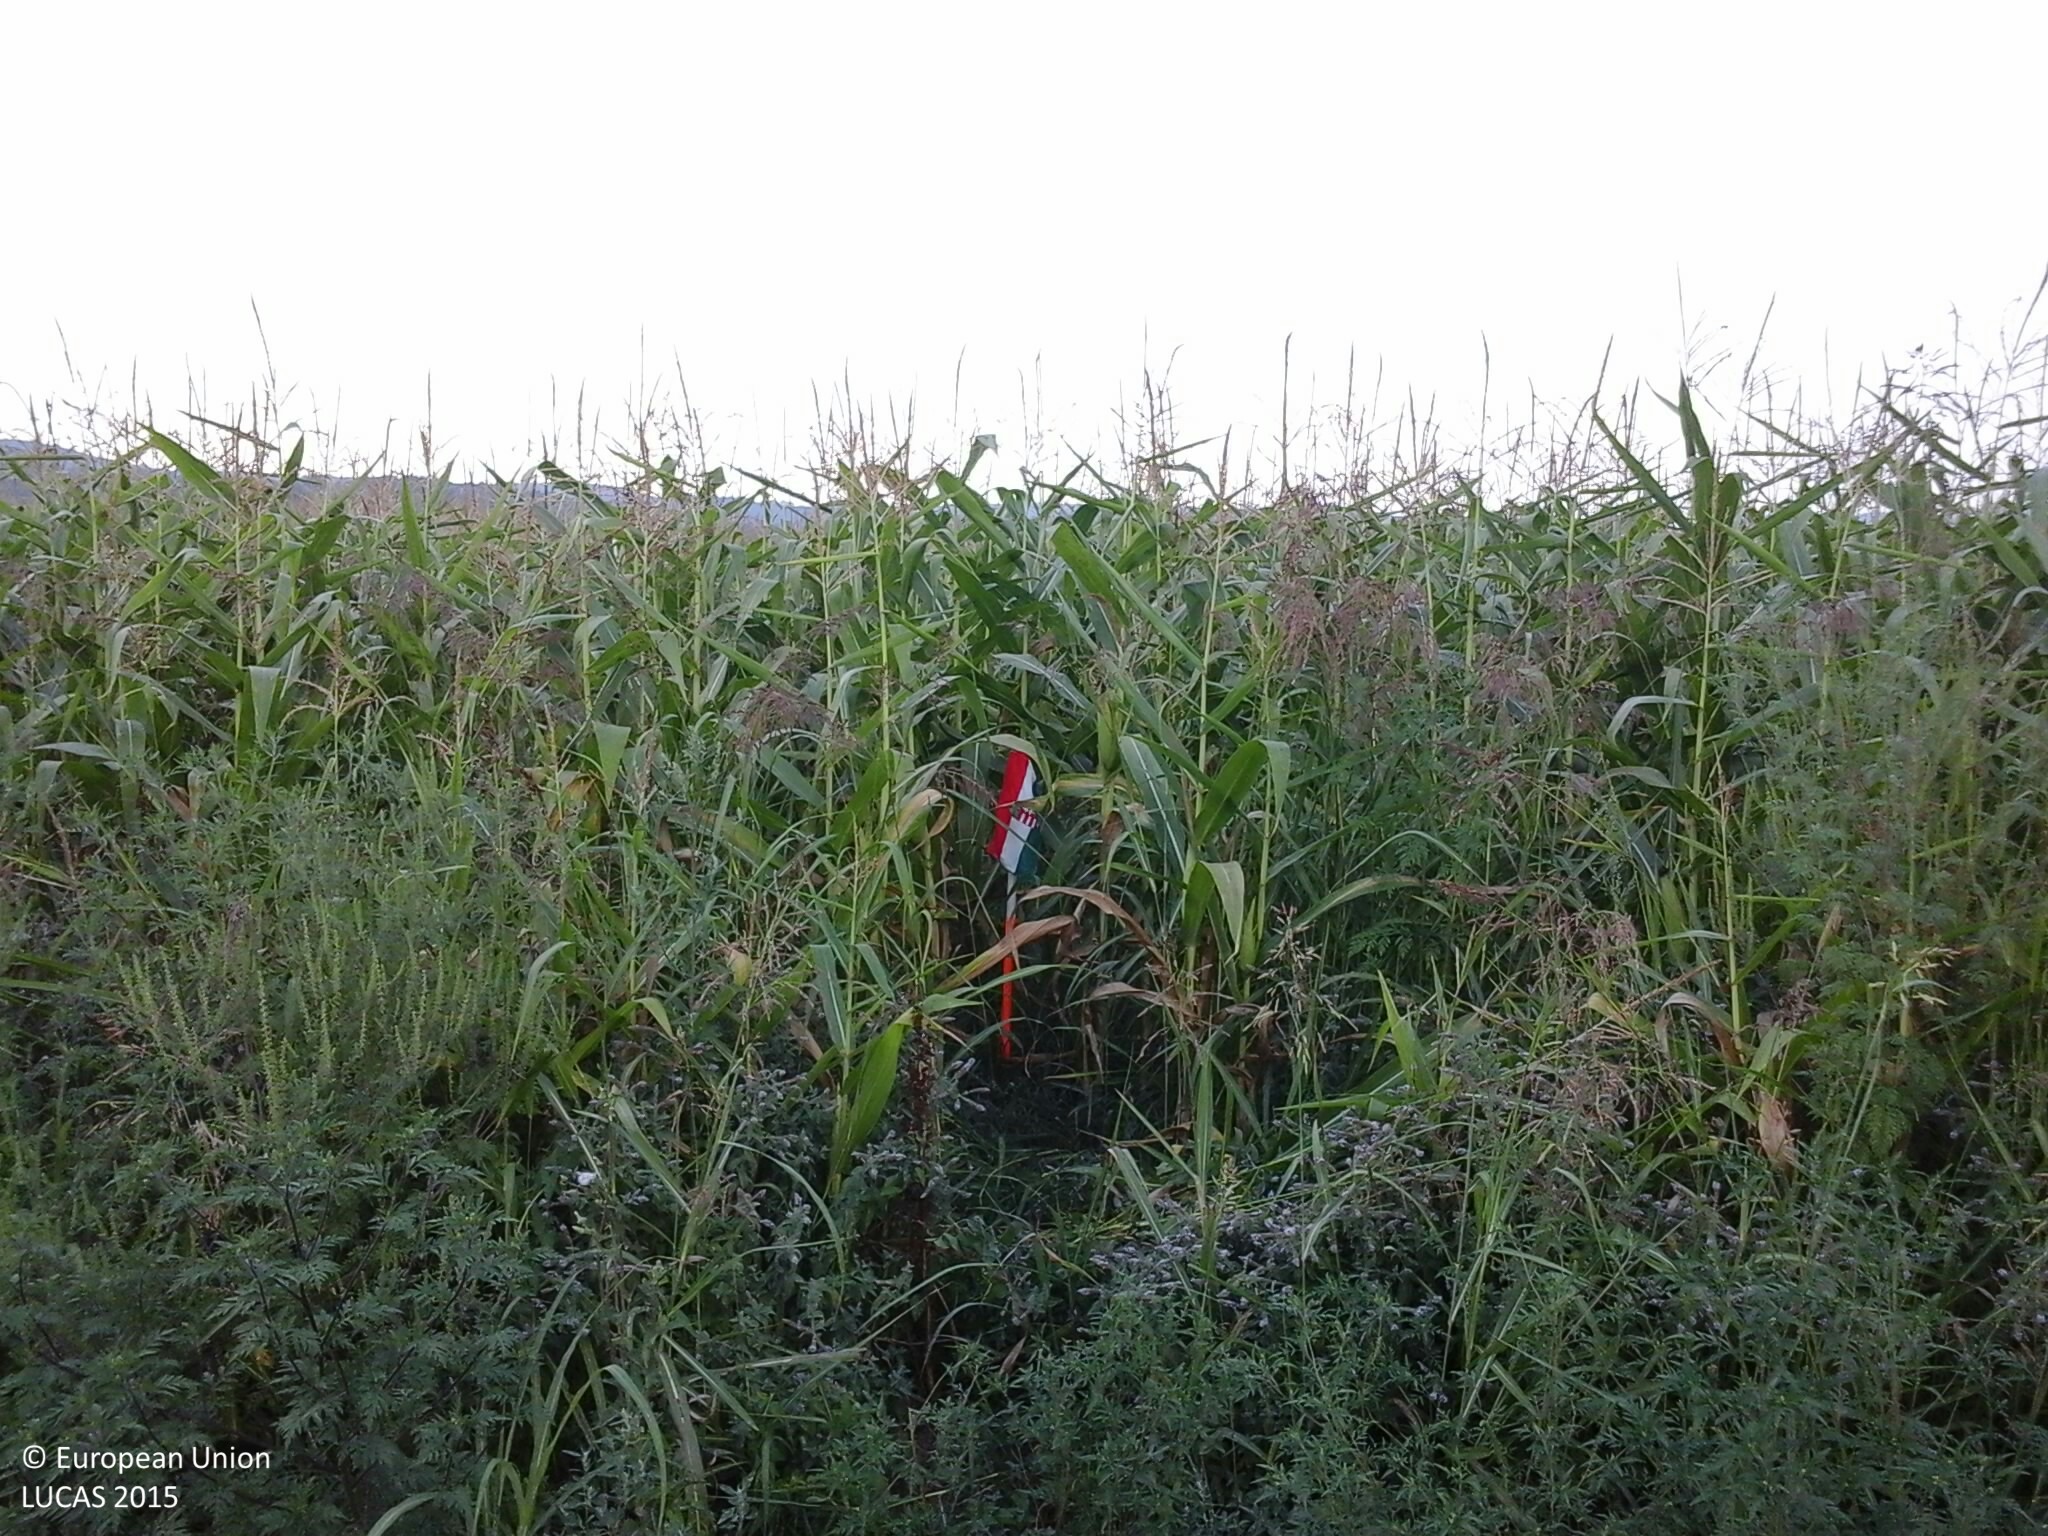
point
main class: Cropland
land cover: Maize
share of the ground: > 75 %
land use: Agriculture (excluding fallow land and kitchen gardens)
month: August
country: HU
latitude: 46.0987
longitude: 18.3253
